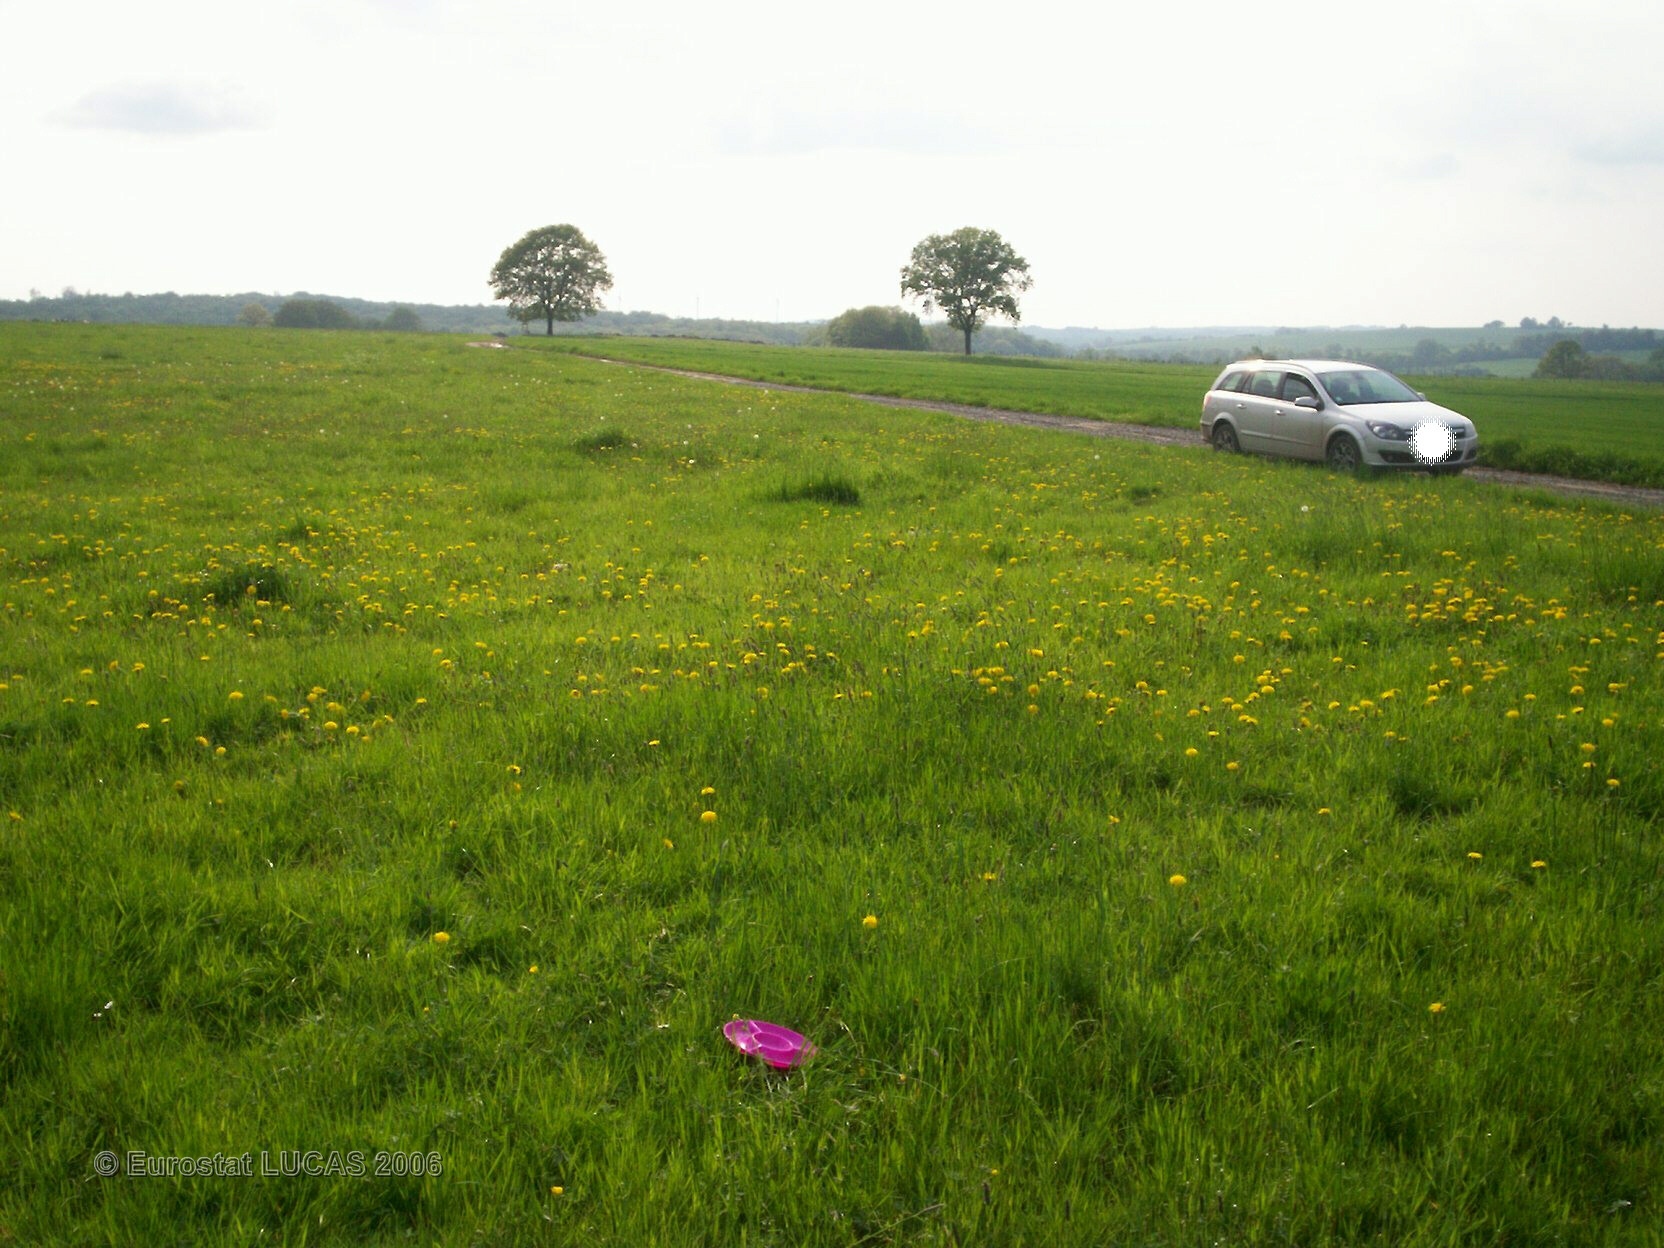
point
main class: Grassland
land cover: Grassland without tree/shrub cover
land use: Agriculture (excluding fallow land and kitchen gardens)
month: May
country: FR
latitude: 48.6315
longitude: 6.9476
